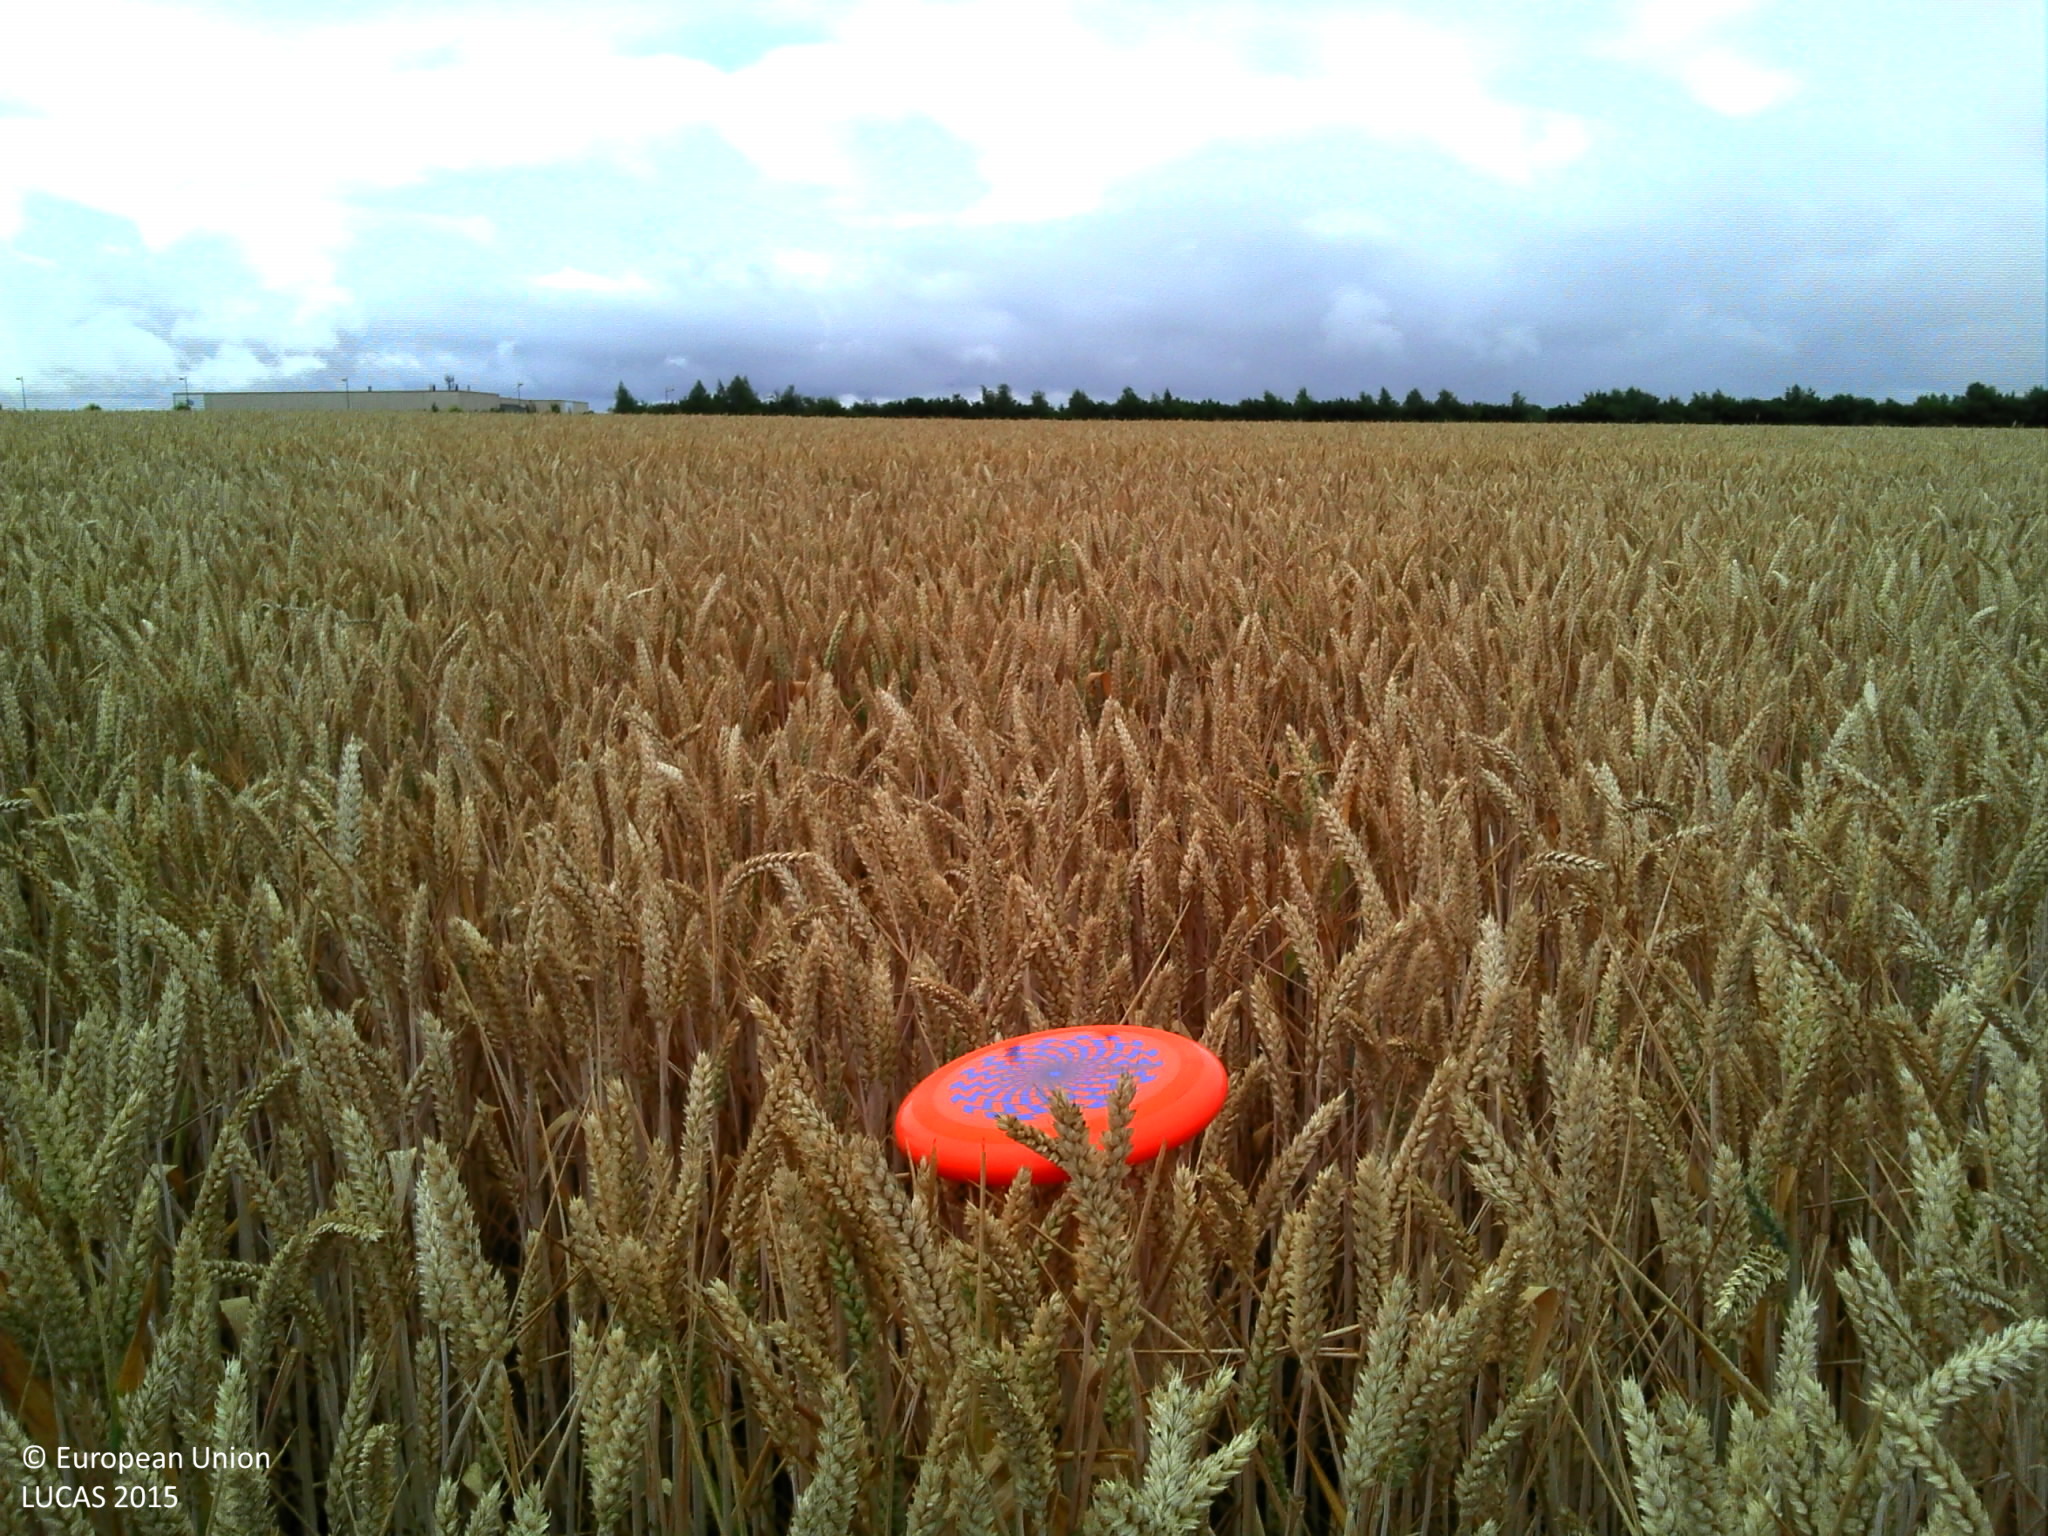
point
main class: Cropland
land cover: Common wheat
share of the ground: > 75 %
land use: Agriculture (excluding fallow land and kitchen gardens)
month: July
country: FR
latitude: 50.1260
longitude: 3.2071
